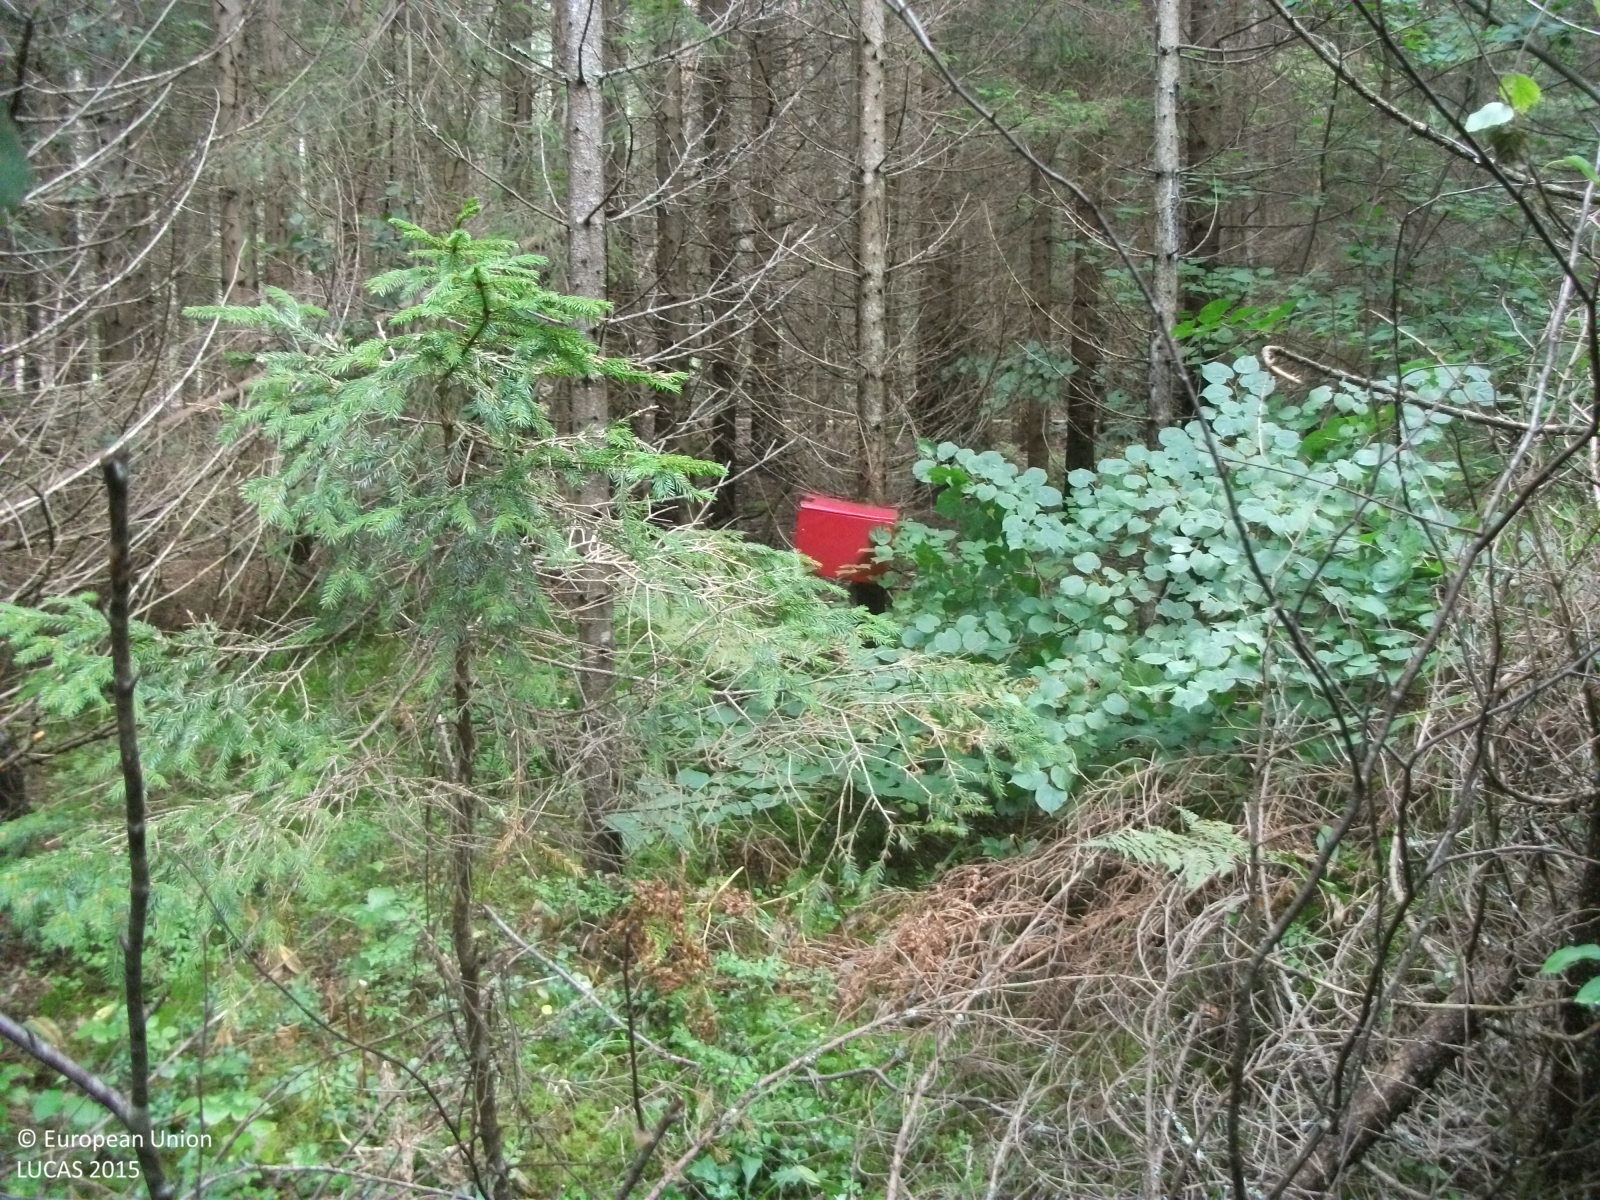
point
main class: Woodland
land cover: Spruce dominated coniferous woodland
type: hemiboreal forest and nemoral coniferous forest and mixed broadleaved-coniferous forest
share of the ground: > 75 %
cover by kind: coniferous forest trees 90 %, broadleaved forest trees 5 %, shrubs 5 %
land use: Forestry
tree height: > 5 m
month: September
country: LV
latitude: 57.6034
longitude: 24.3962
